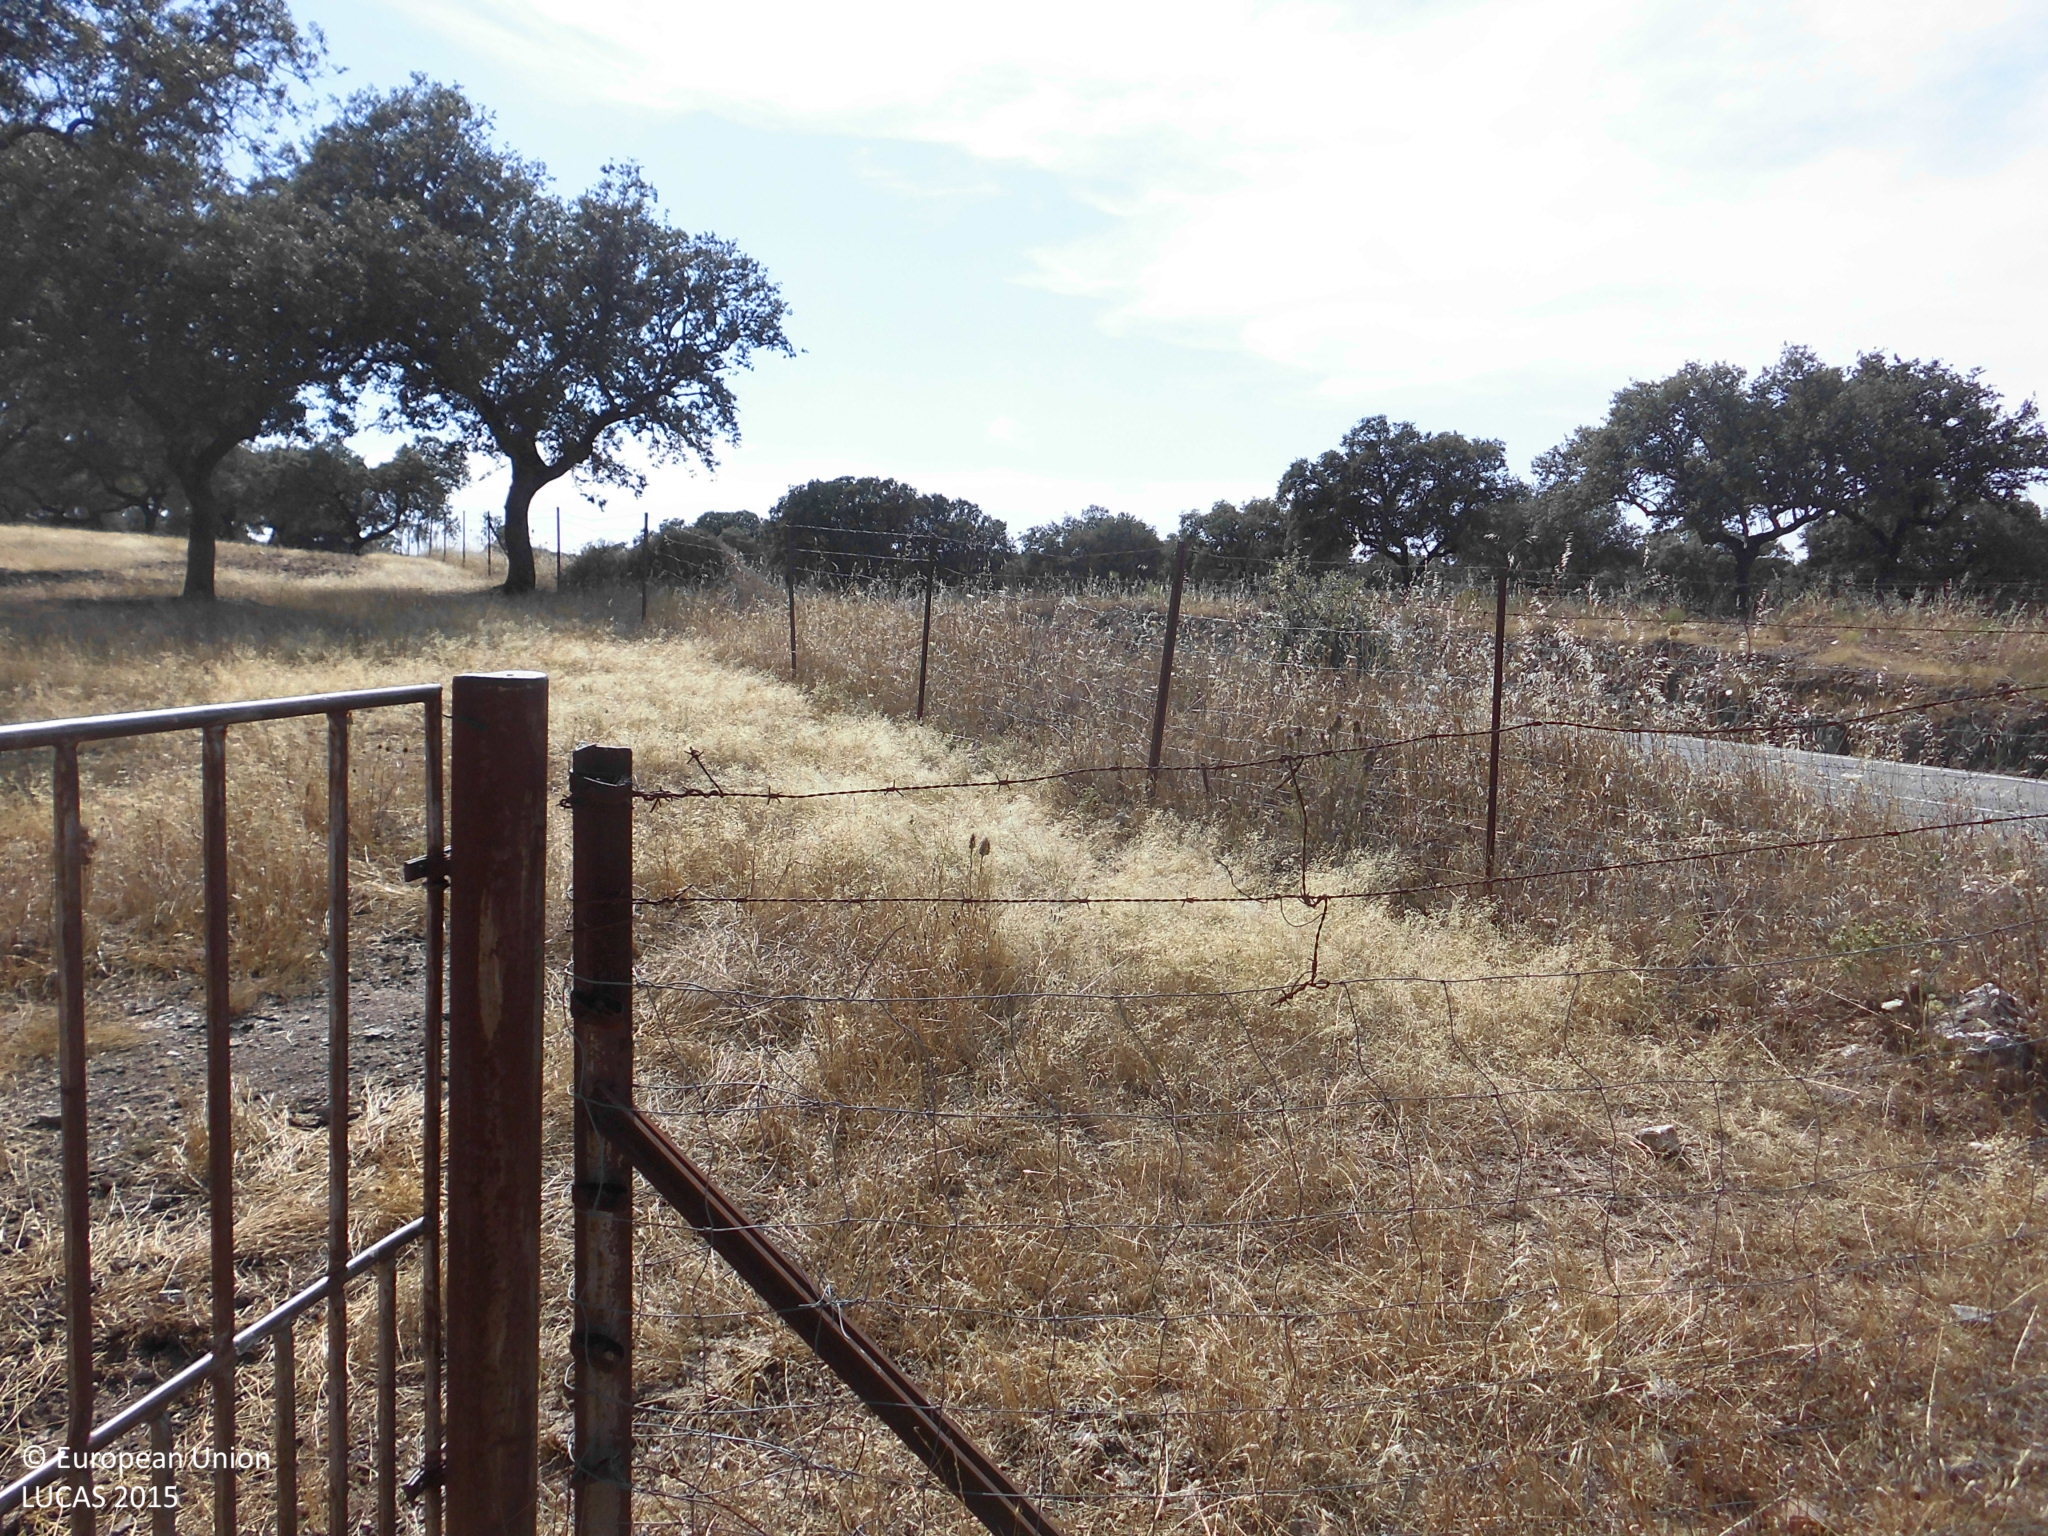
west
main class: Woodland
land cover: Broadleaved woodland
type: broadleaved evergreen forest
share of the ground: 25 - 50 %
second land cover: Grassland without tree/shrub cover
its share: > 75 %
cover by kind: herbaceous plants 70 %, broadleaved forest trees 30 %
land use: Forestry
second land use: Agriculture (excluding fallow land and kitchen gardens)
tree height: > 5 m
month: June
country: ES
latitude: 39.7434
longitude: -6.0656
